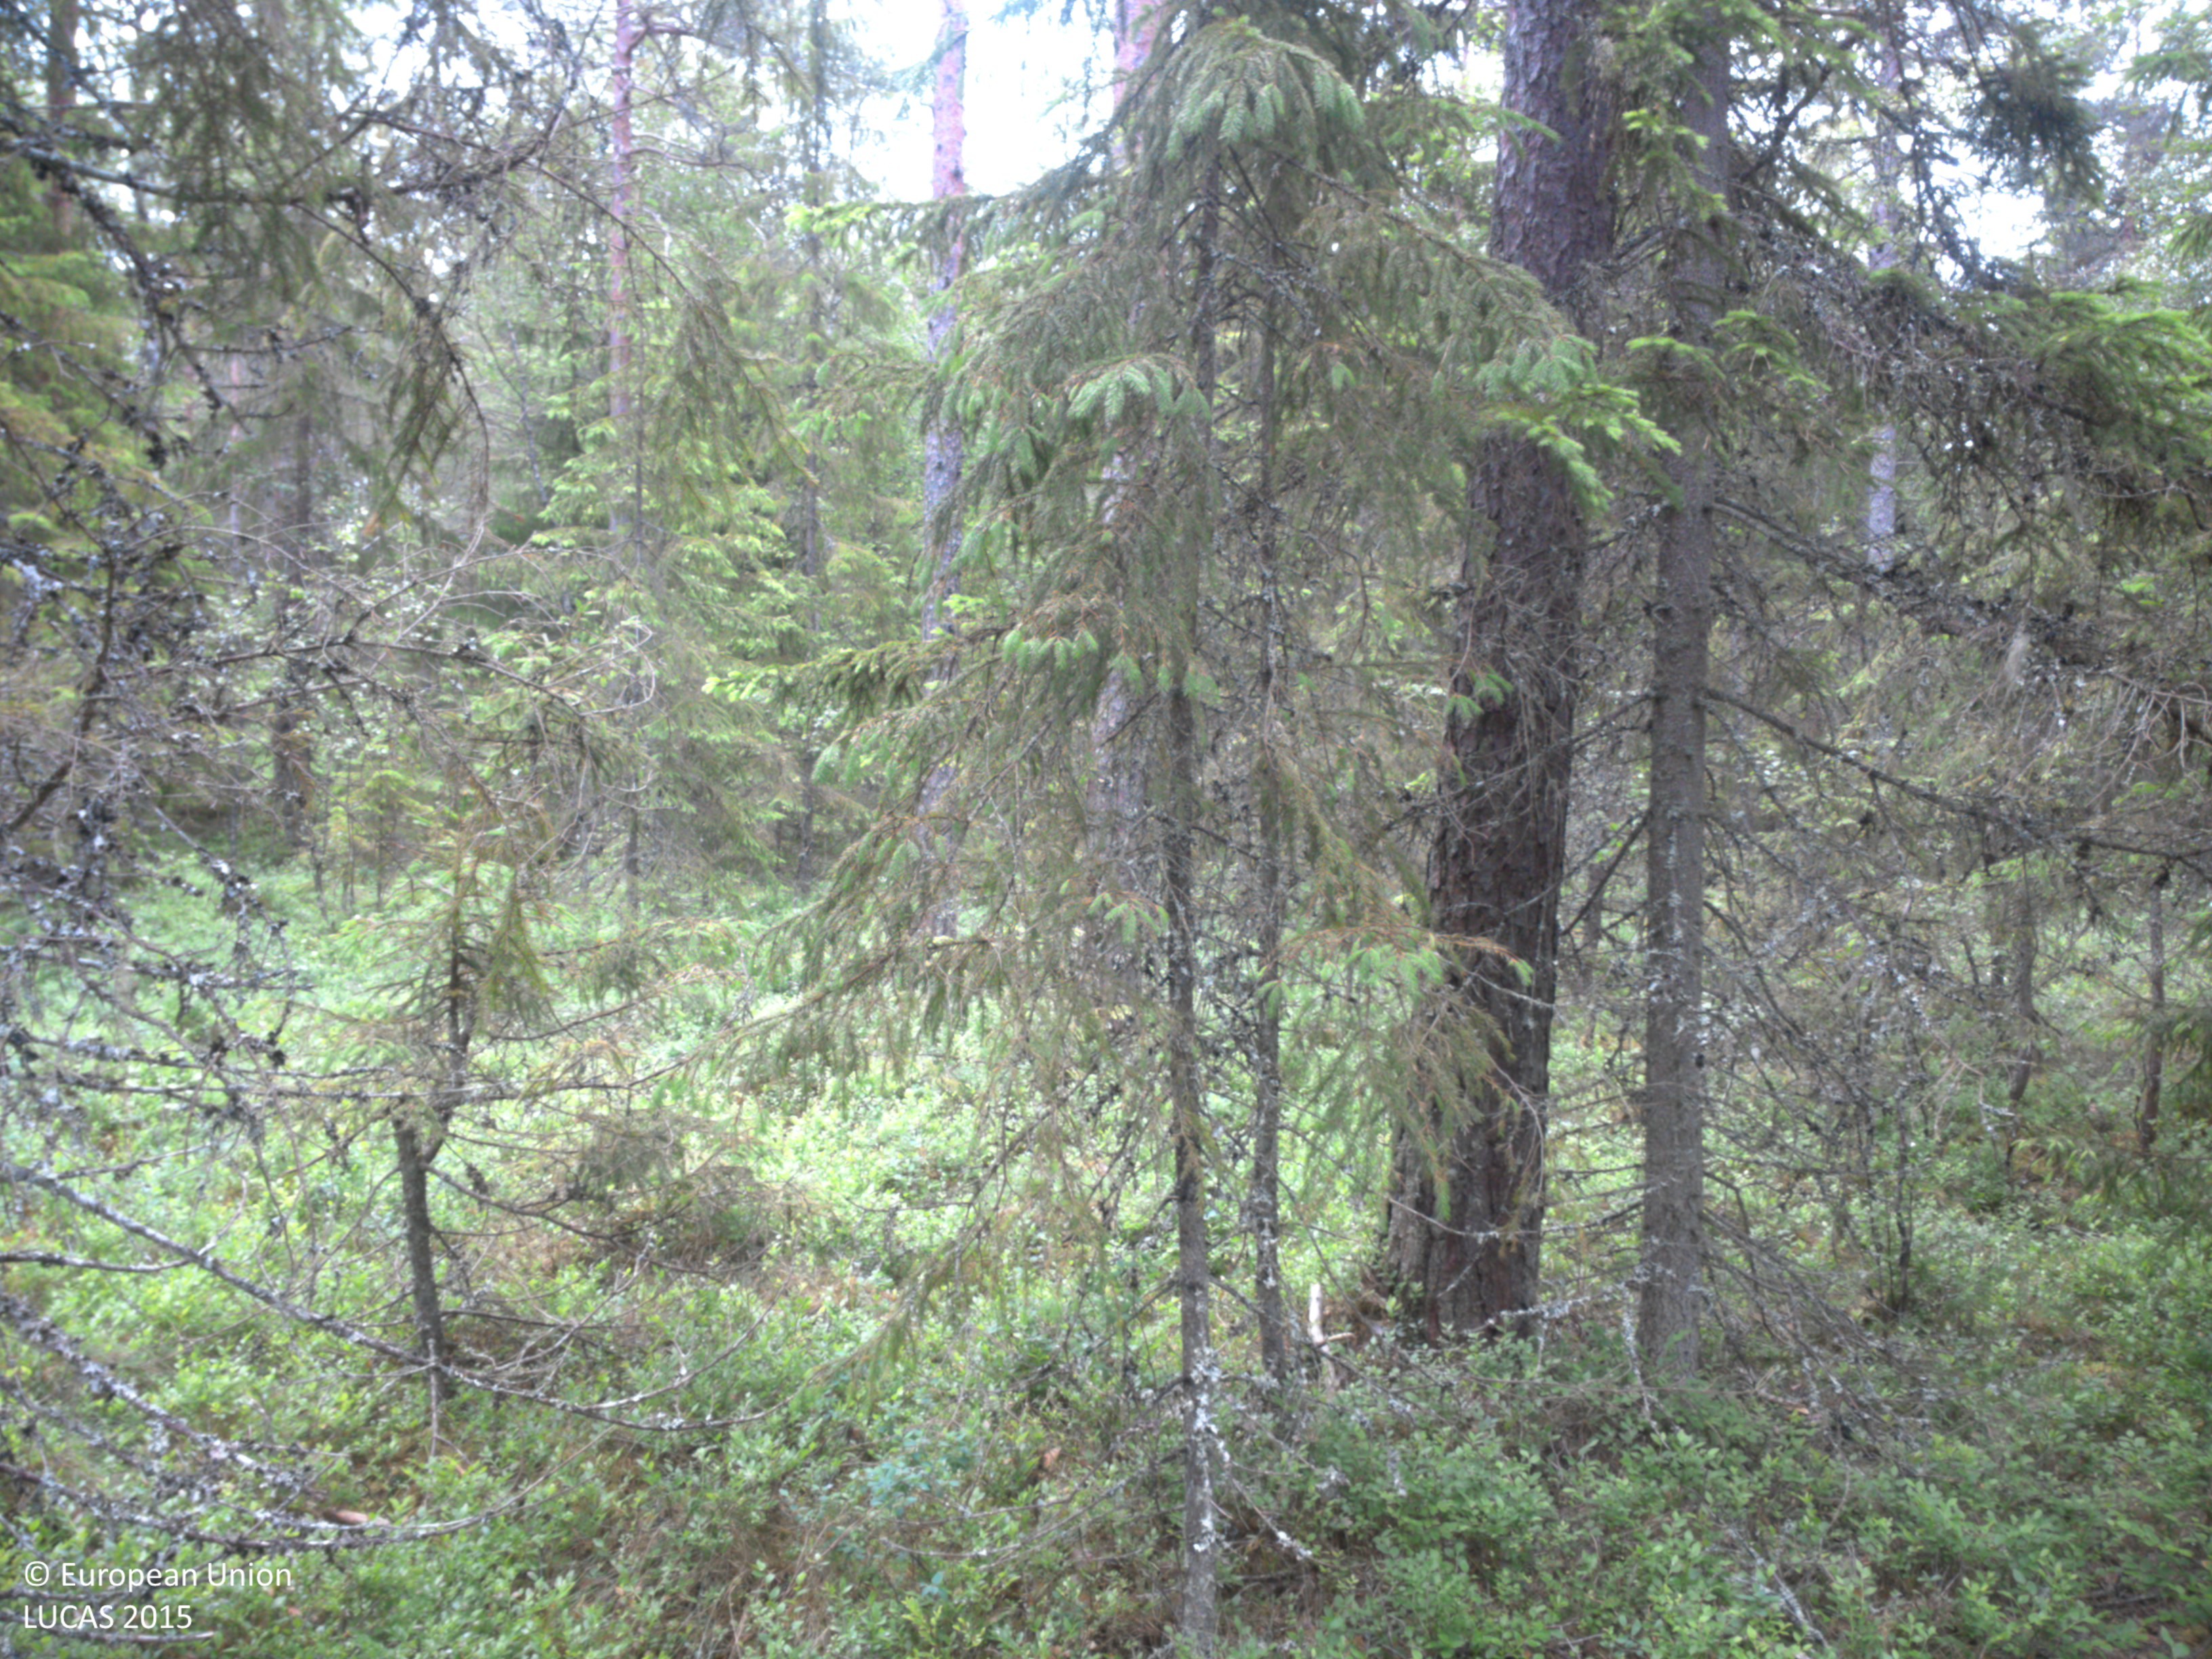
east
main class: Woodland
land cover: Spruce dominated coniferous woodland
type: boreal forest
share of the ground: 50 - 75 %
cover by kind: coniferous forest trees 50 %, lichens and mosses 40 %, herbaceous plants 10 %
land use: Forestry
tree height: > 5 m
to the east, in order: Spruce dominated coniferous woodland; Pine dominated coniferous woodland; Spruce dominated mixed woodland; Tracks; Grassland without tree/shrub cover; Spruce dominated coniferous woodland
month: June
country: SE
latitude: 58.9419
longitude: 12.0286
